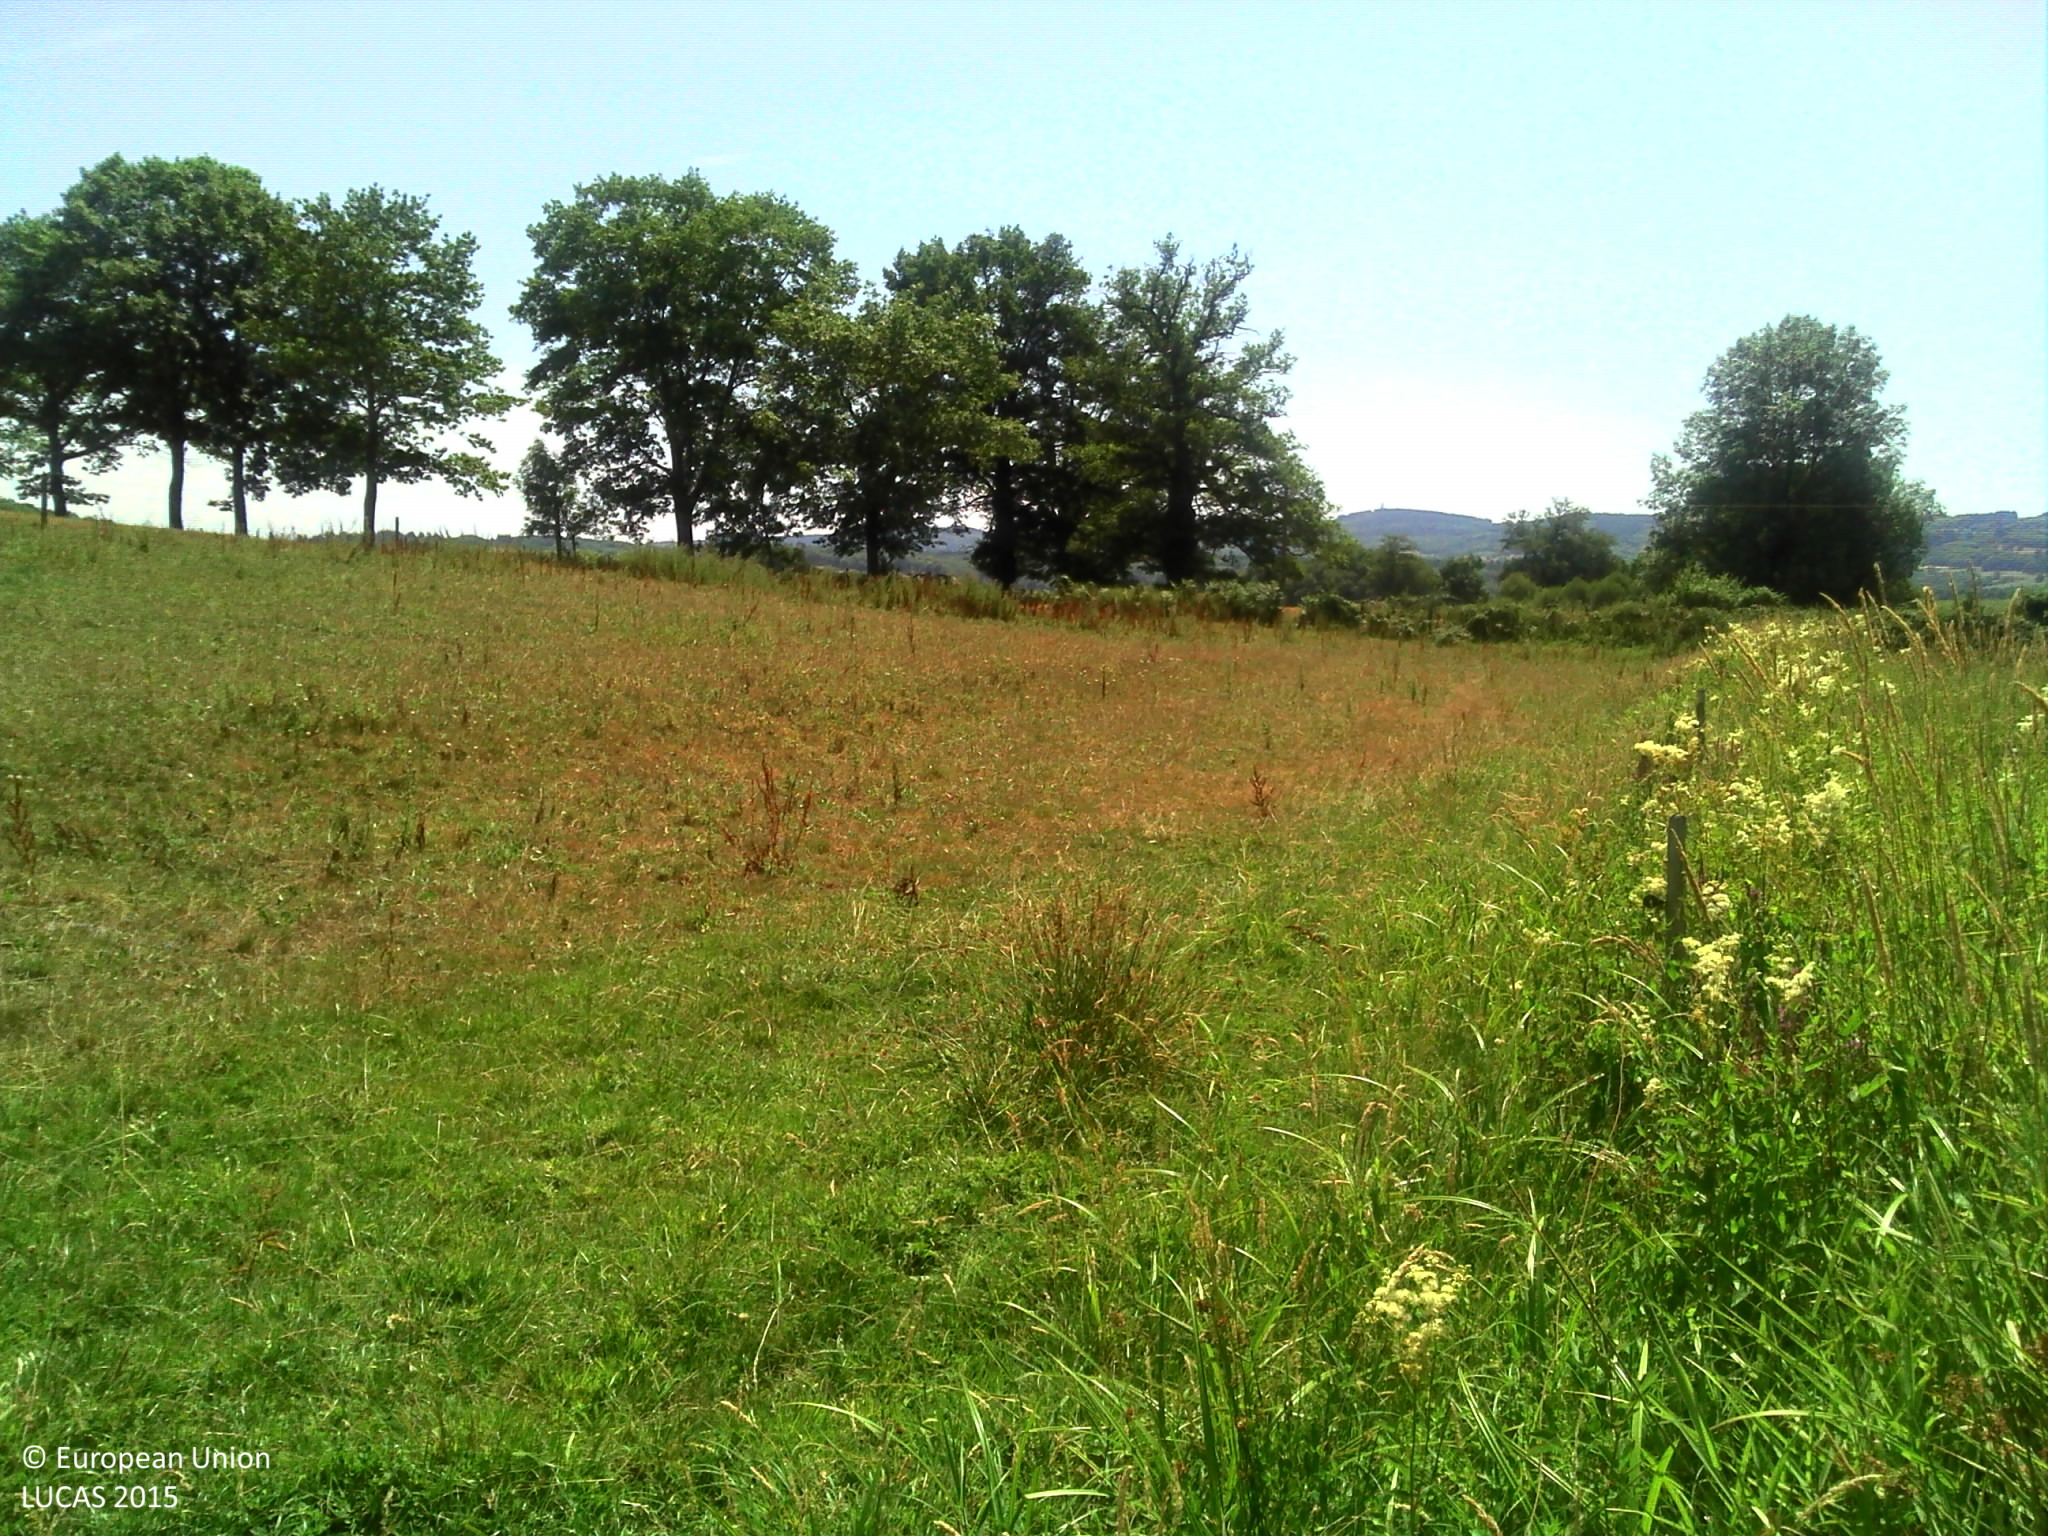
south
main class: Grassland
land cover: Grassland without tree/shrub cover
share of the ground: > 75 %
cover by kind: herbaceous plants 95 %, shrubs 5 %
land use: Agriculture (excluding fallow land and kitchen gardens)
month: July
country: FR
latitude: 46.1084
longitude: 1.5691
